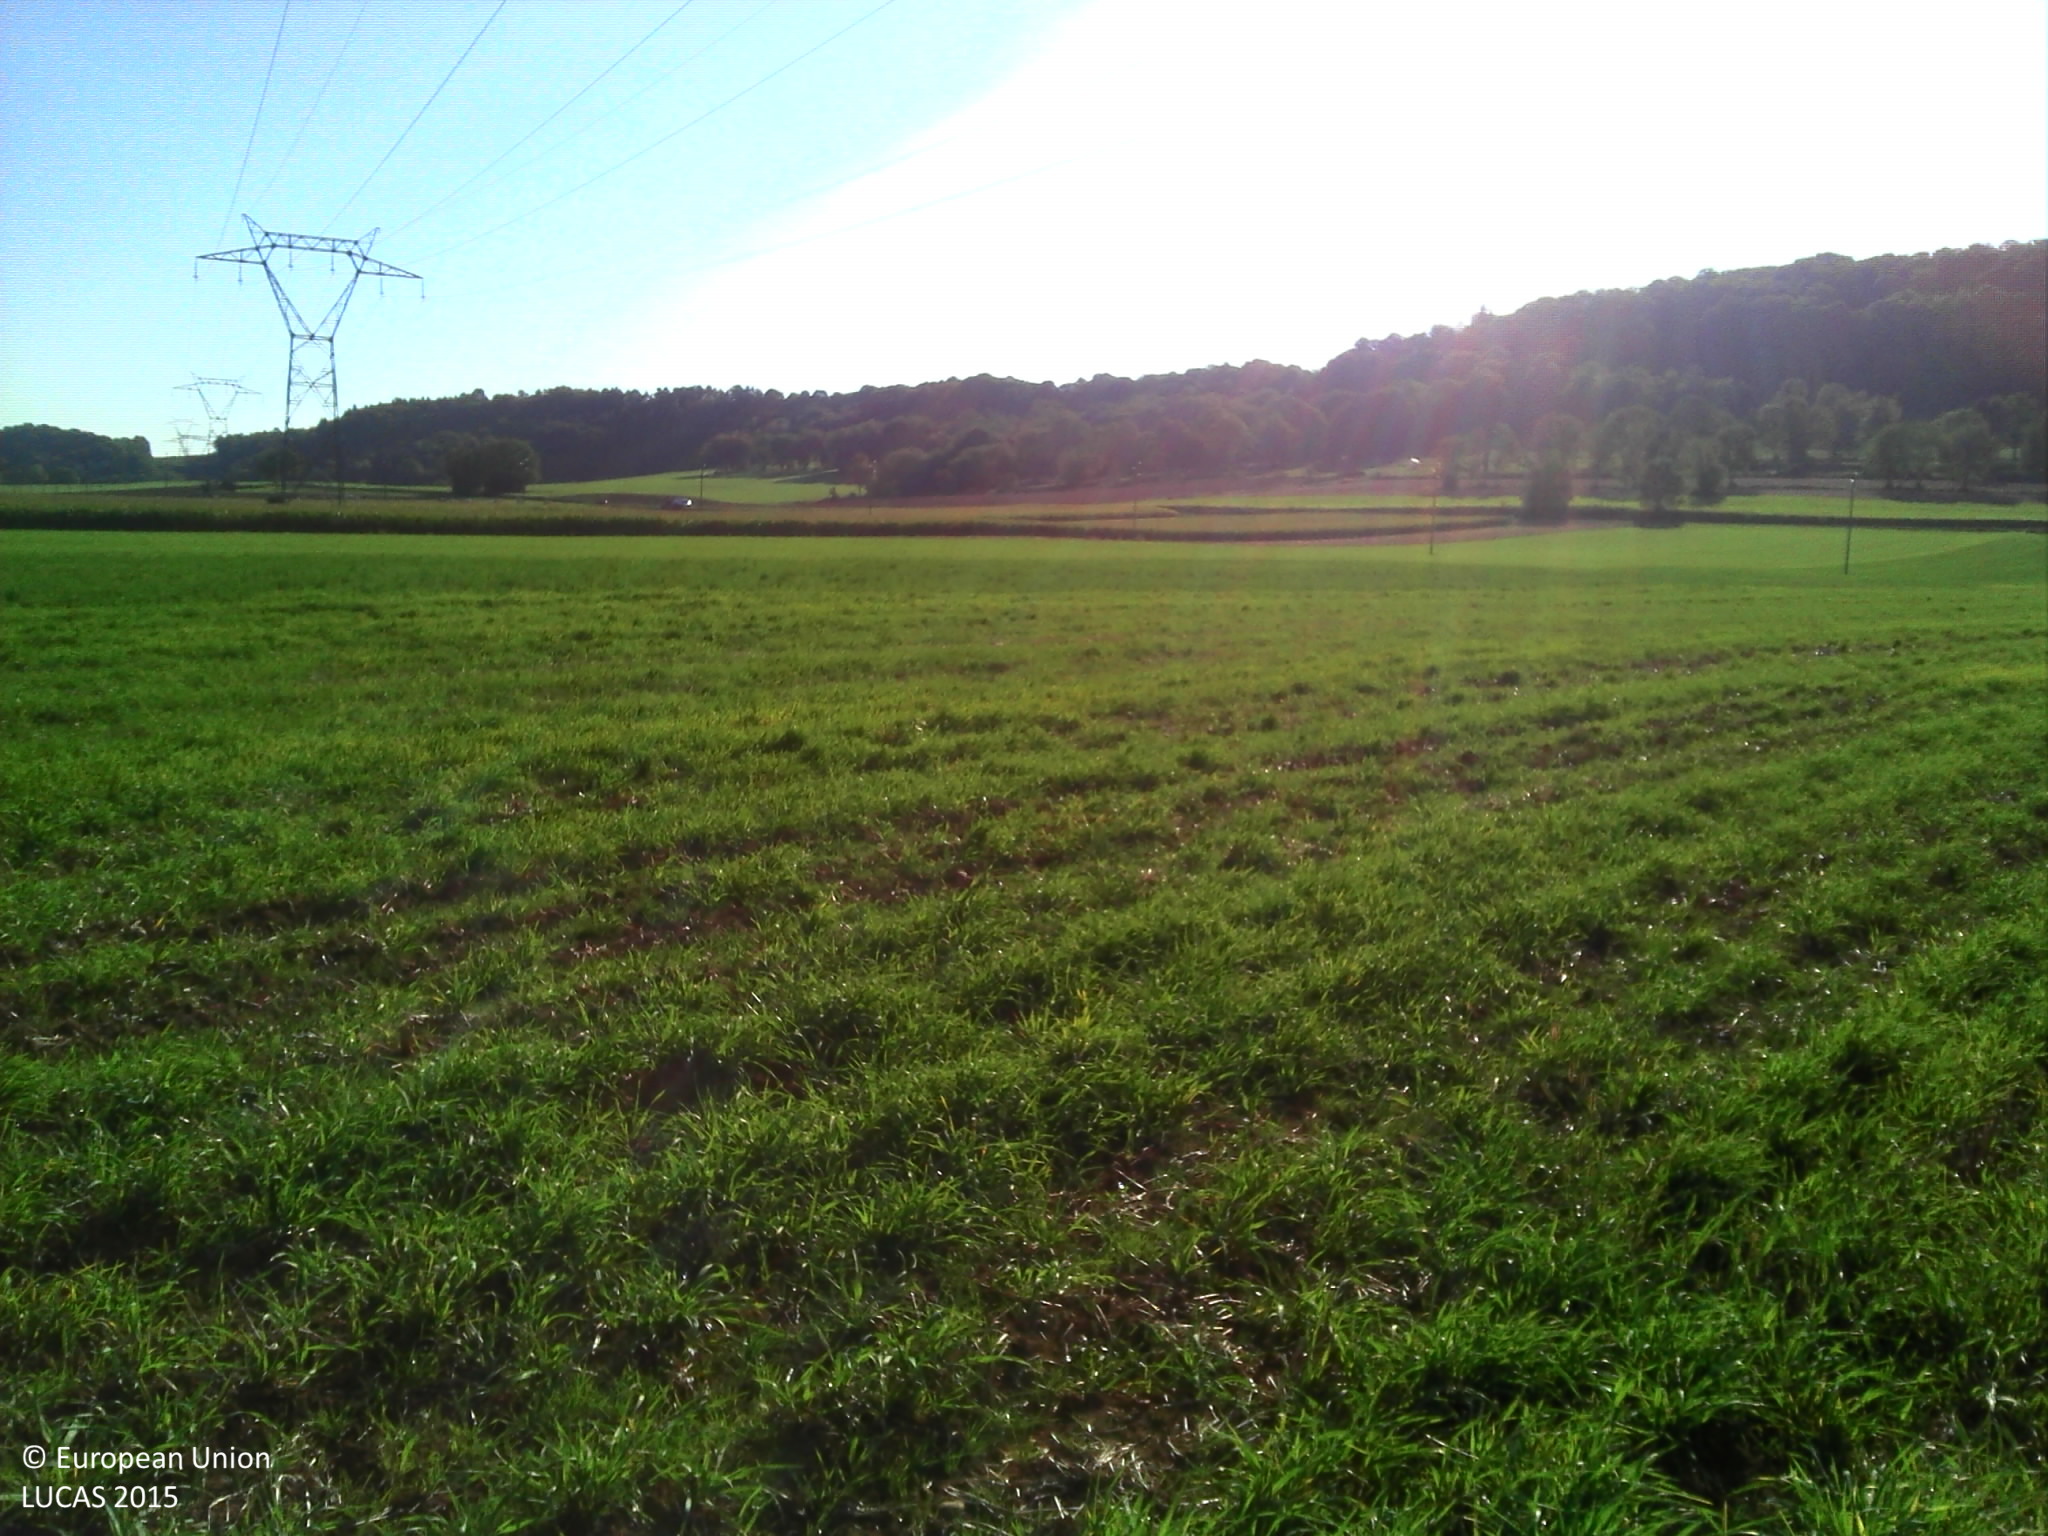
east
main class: Cropland
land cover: Temporary grasslands
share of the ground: > 75 %
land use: Agriculture (excluding fallow land and kitchen gardens)
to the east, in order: Temporary grasslands; Electric lines; Temporary grasslands; Maize
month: September
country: FR
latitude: 47.2800
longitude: 6.3398
